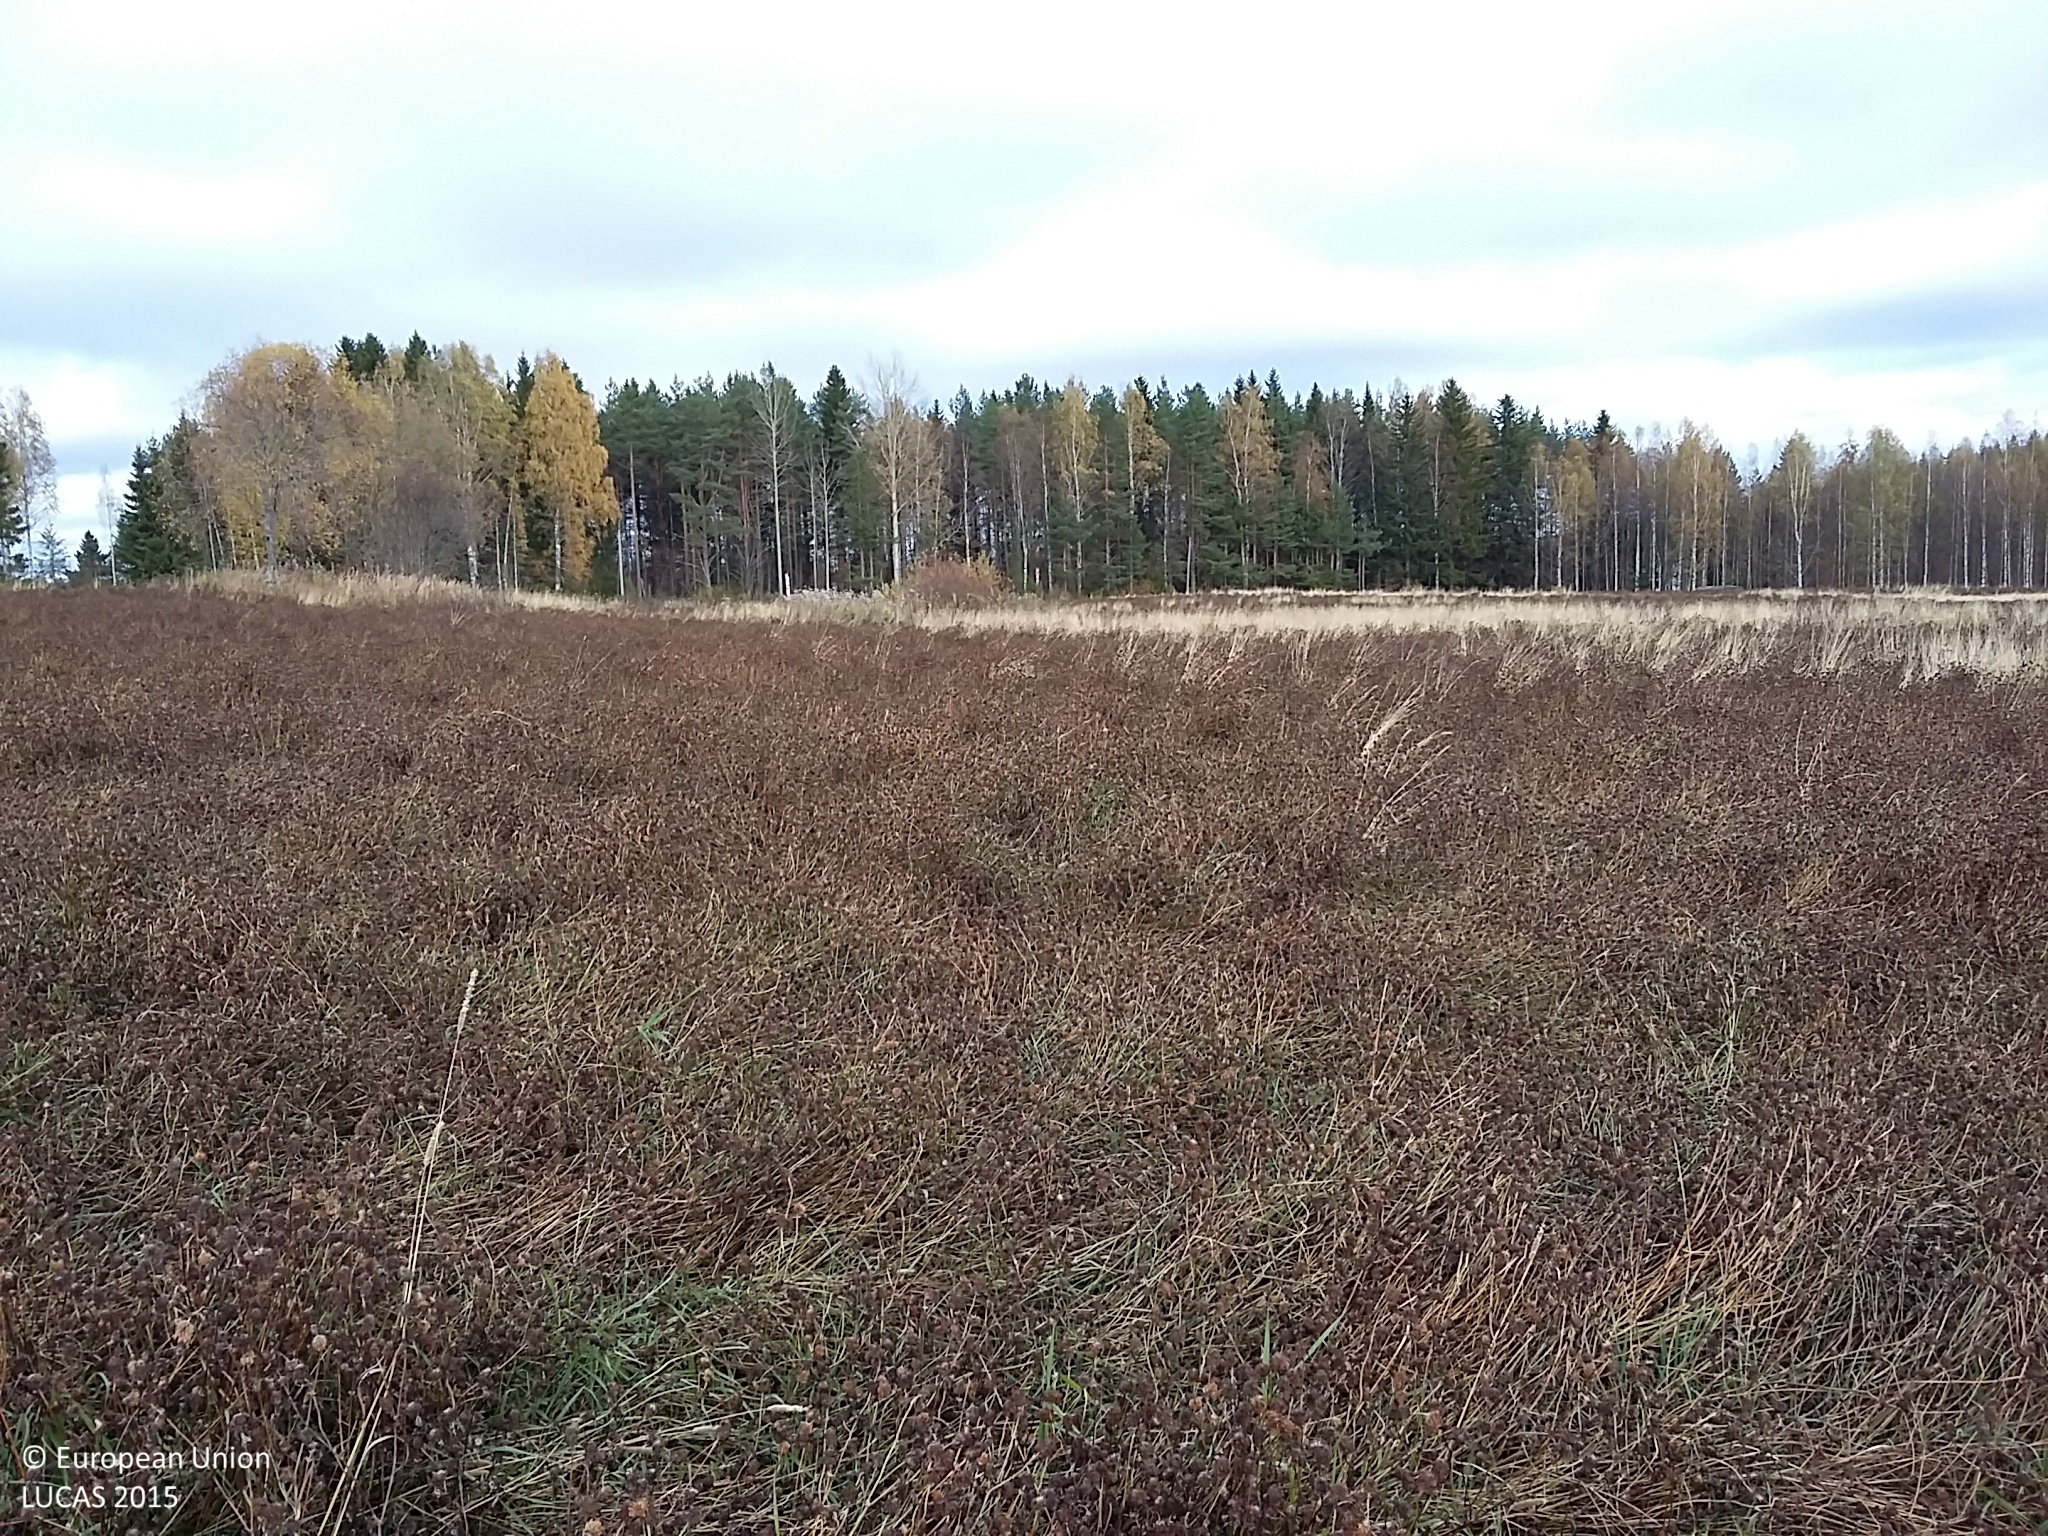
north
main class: Cropland
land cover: Other leguminous and mixtures for fodder
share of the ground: > 75 %
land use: Agriculture (excluding fallow land and kitchen gardens)
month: October
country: FI
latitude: 62.5481
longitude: 26.2891
